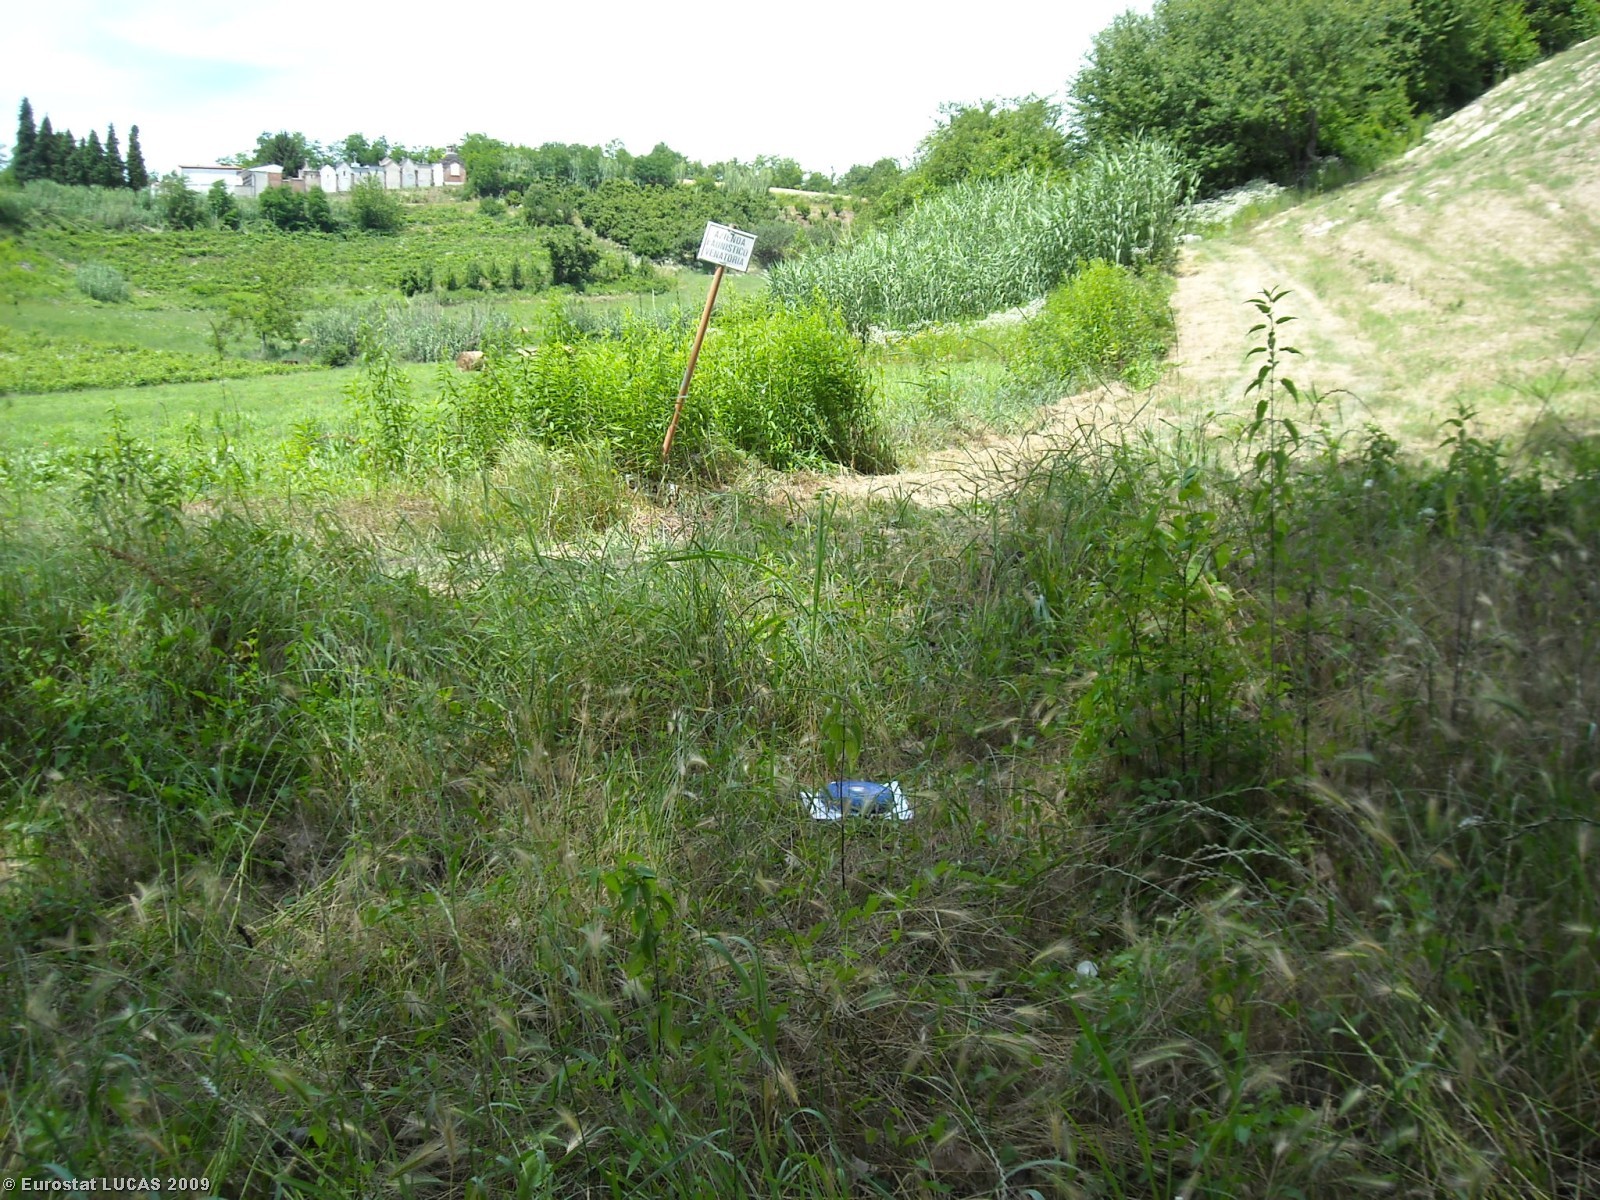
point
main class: Grassland
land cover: Spontaneously vegetated surfaces
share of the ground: > 75 %
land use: Fallow land
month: June
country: IT
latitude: 45.0003
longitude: 8.0880
